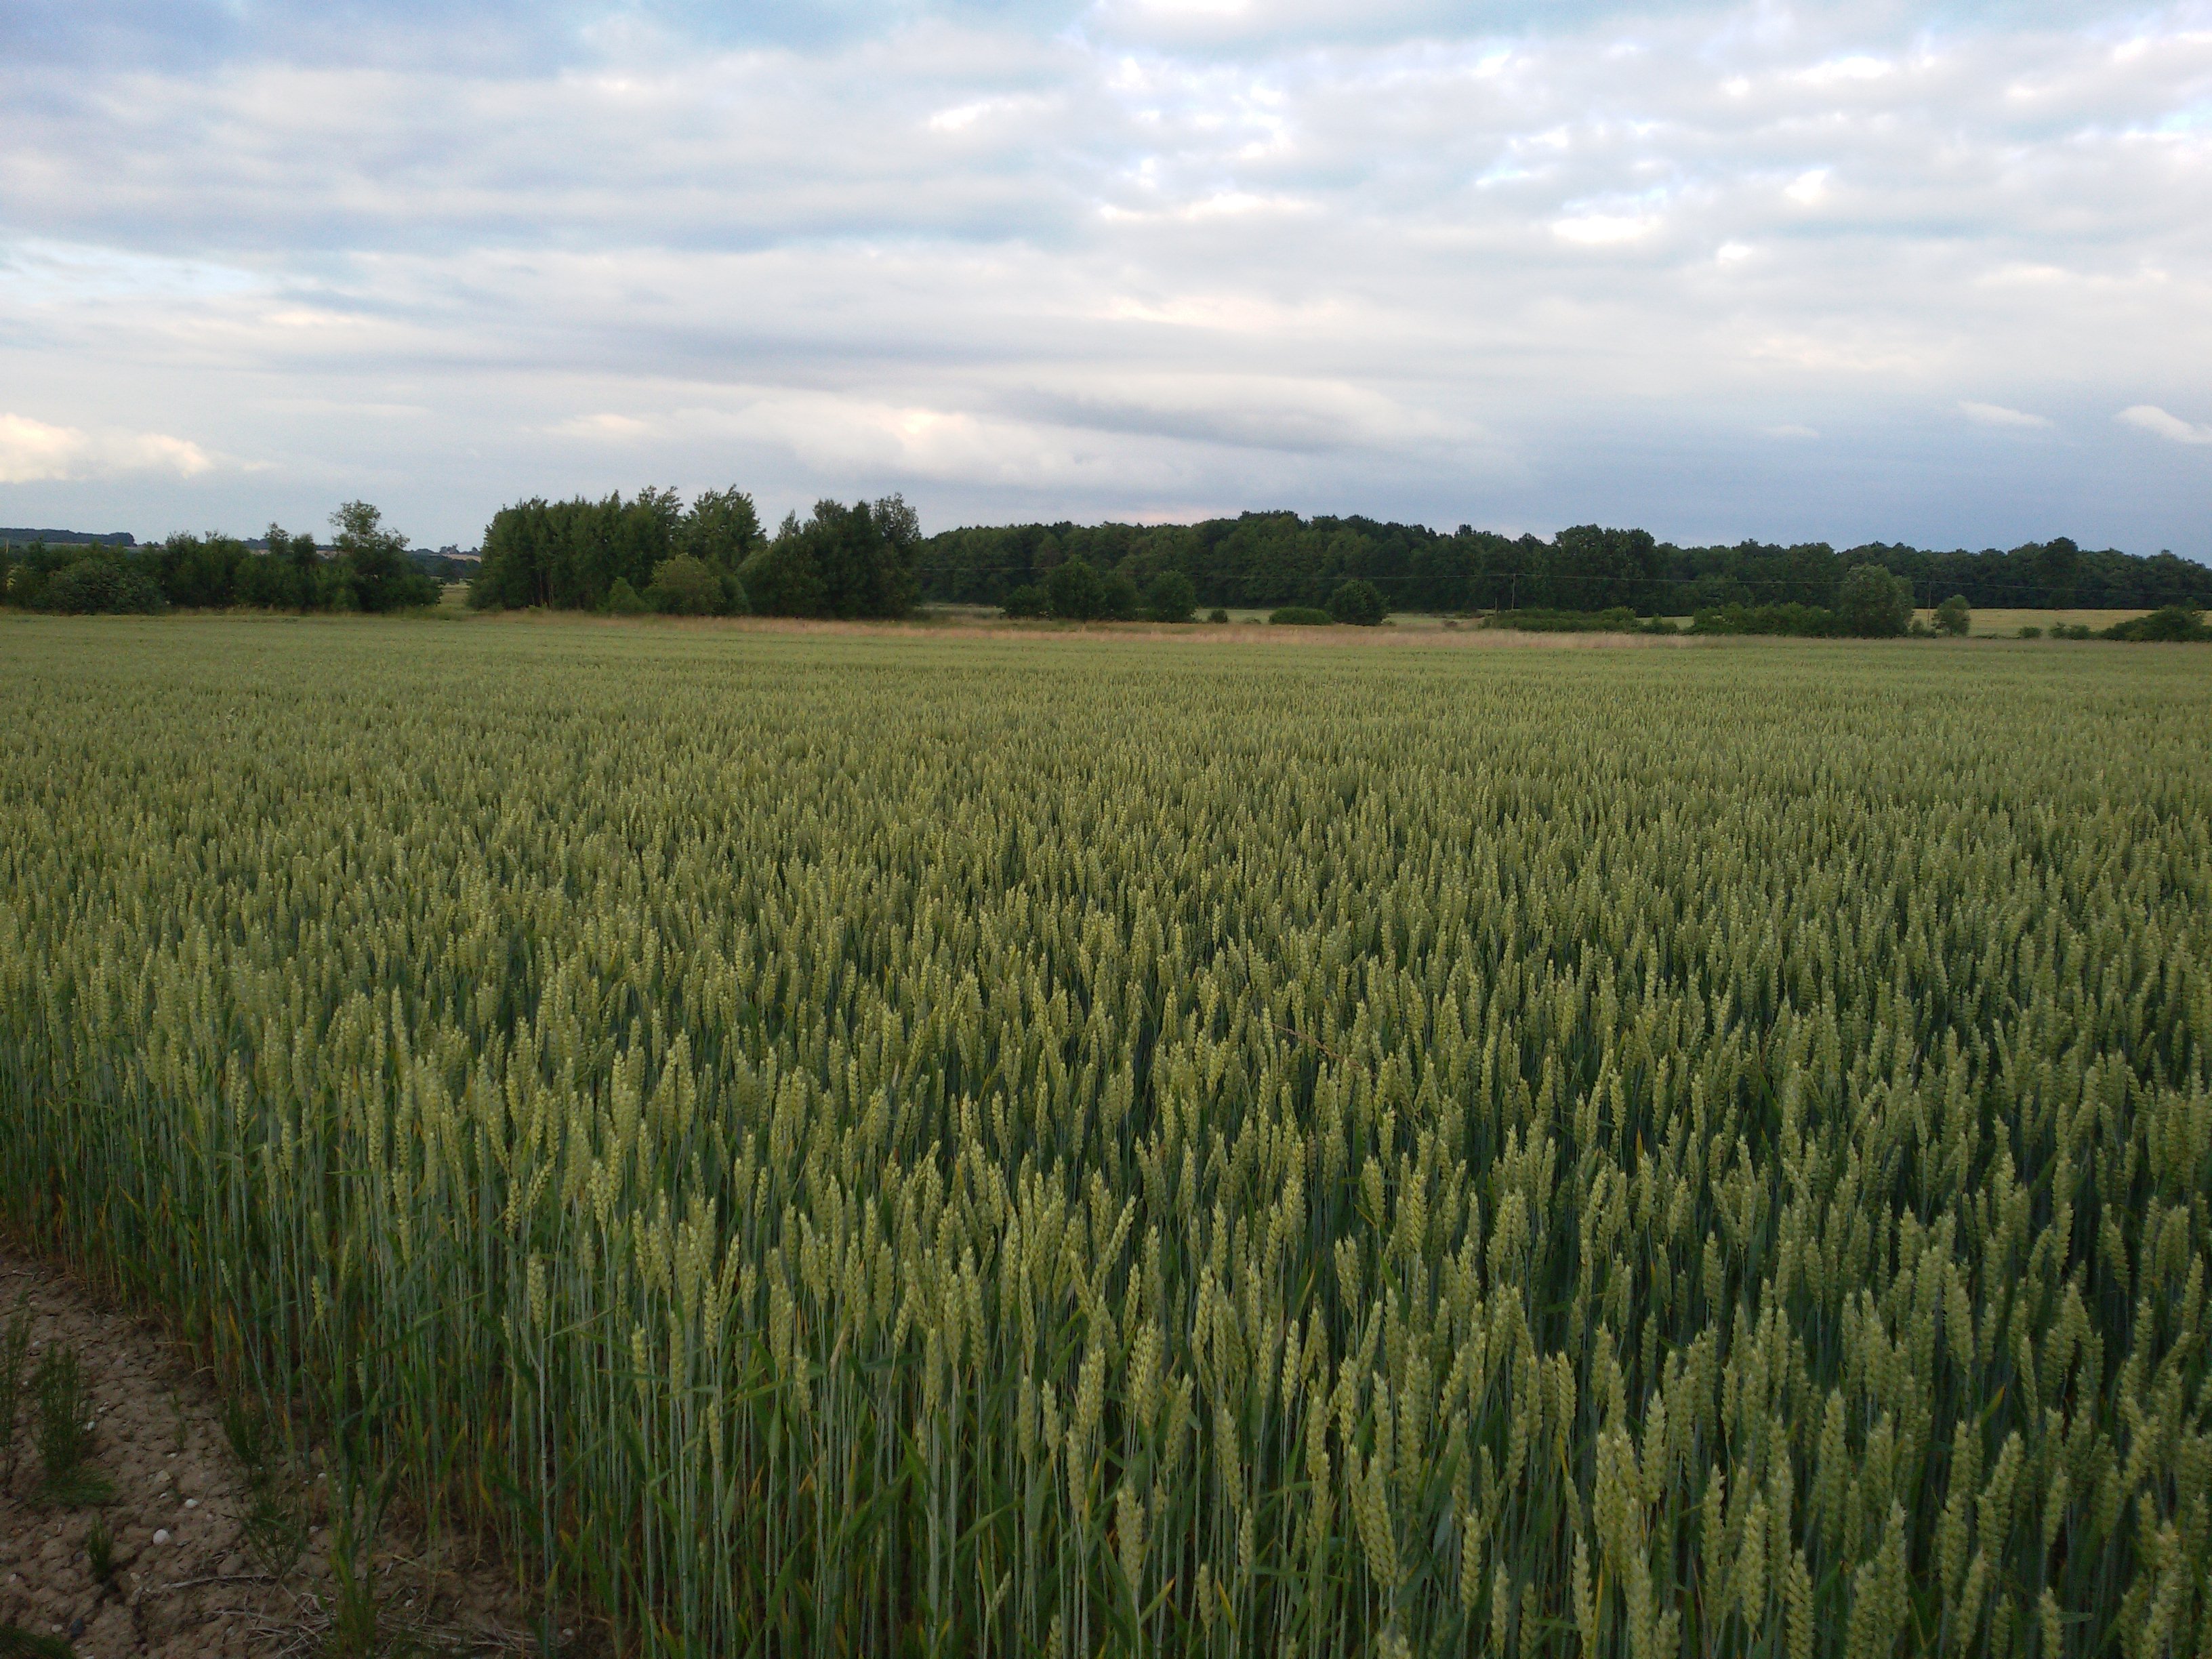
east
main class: Cropland
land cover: Common wheat
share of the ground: > 75 %
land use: Agriculture (excluding fallow land and kitchen gardens)
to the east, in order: Common wheat; Single bushes/trees; Paved roads, cycling and walking lanes; Grass margins; Common wheat; Grassland without tree/shrub cover
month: June
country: PL
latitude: 50.6599
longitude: 17.2116
